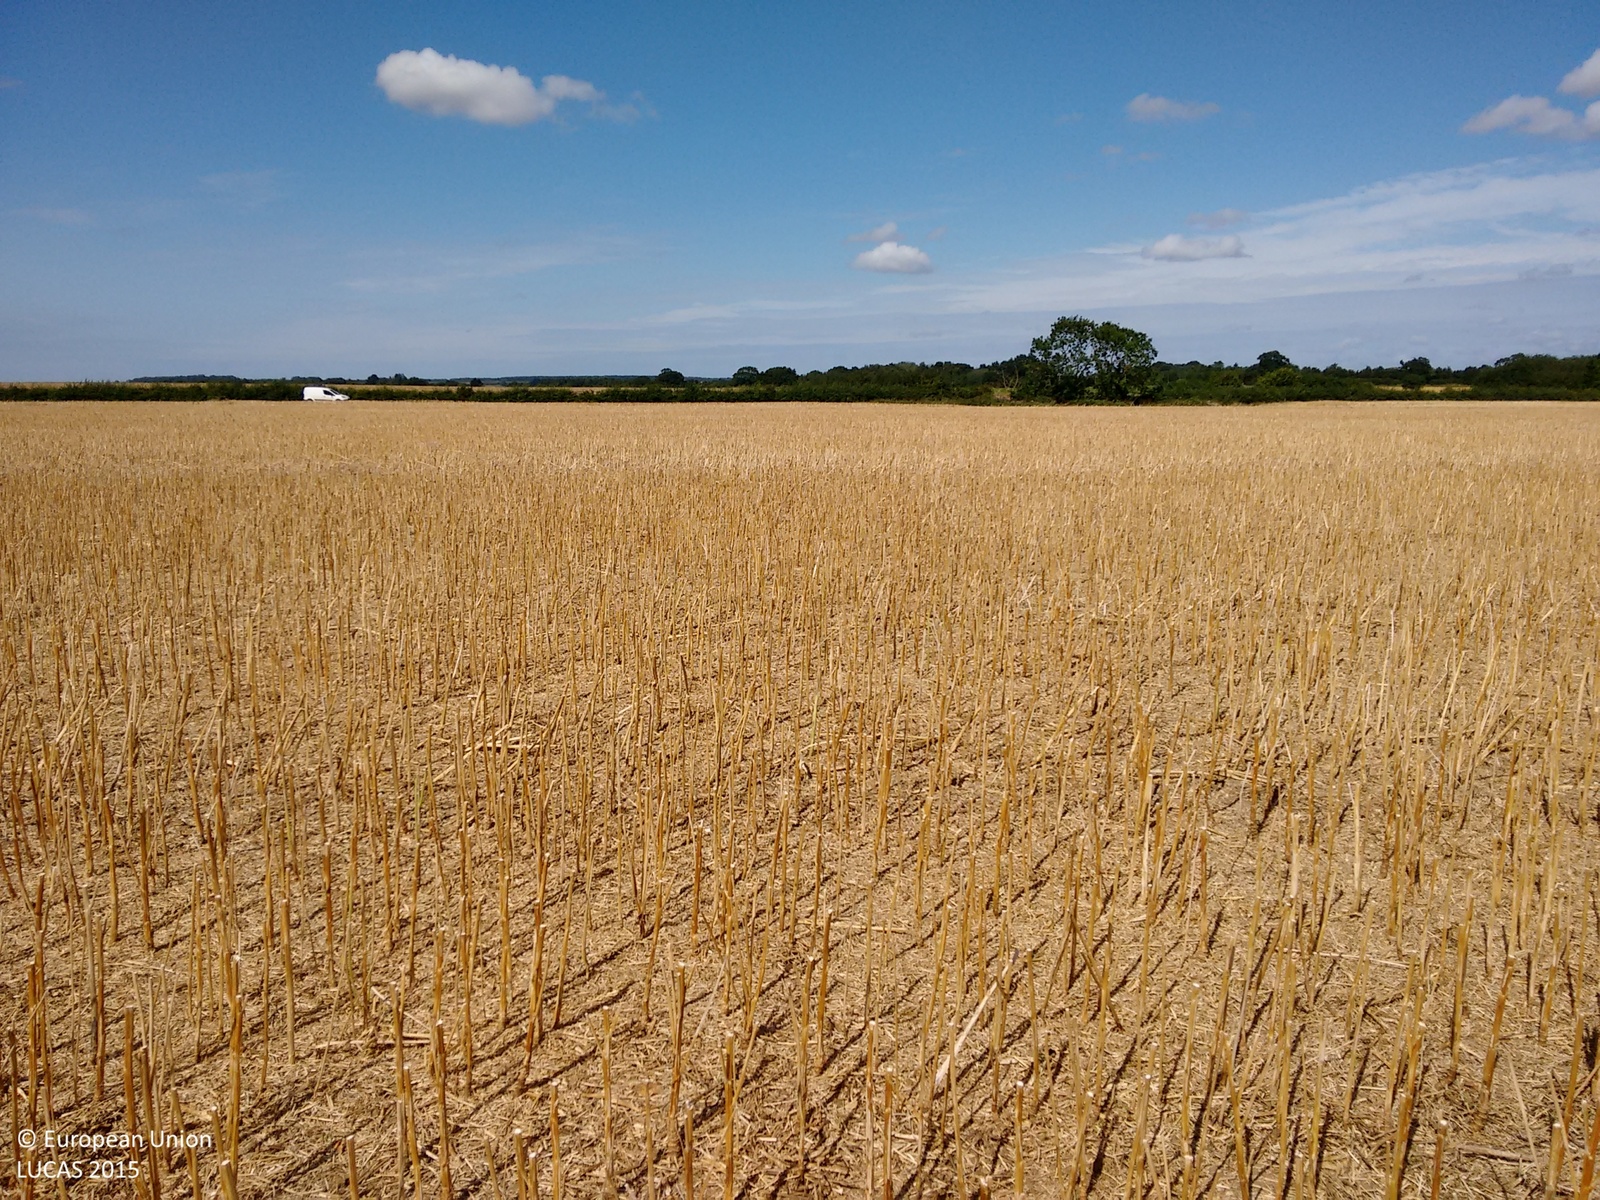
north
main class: Cropland
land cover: Rape and turnip rape
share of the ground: > 75 %
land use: Agriculture (excluding fallow land and kitchen gardens)
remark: Harvested field
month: August
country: GB
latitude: 52.7106
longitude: 0.8431
